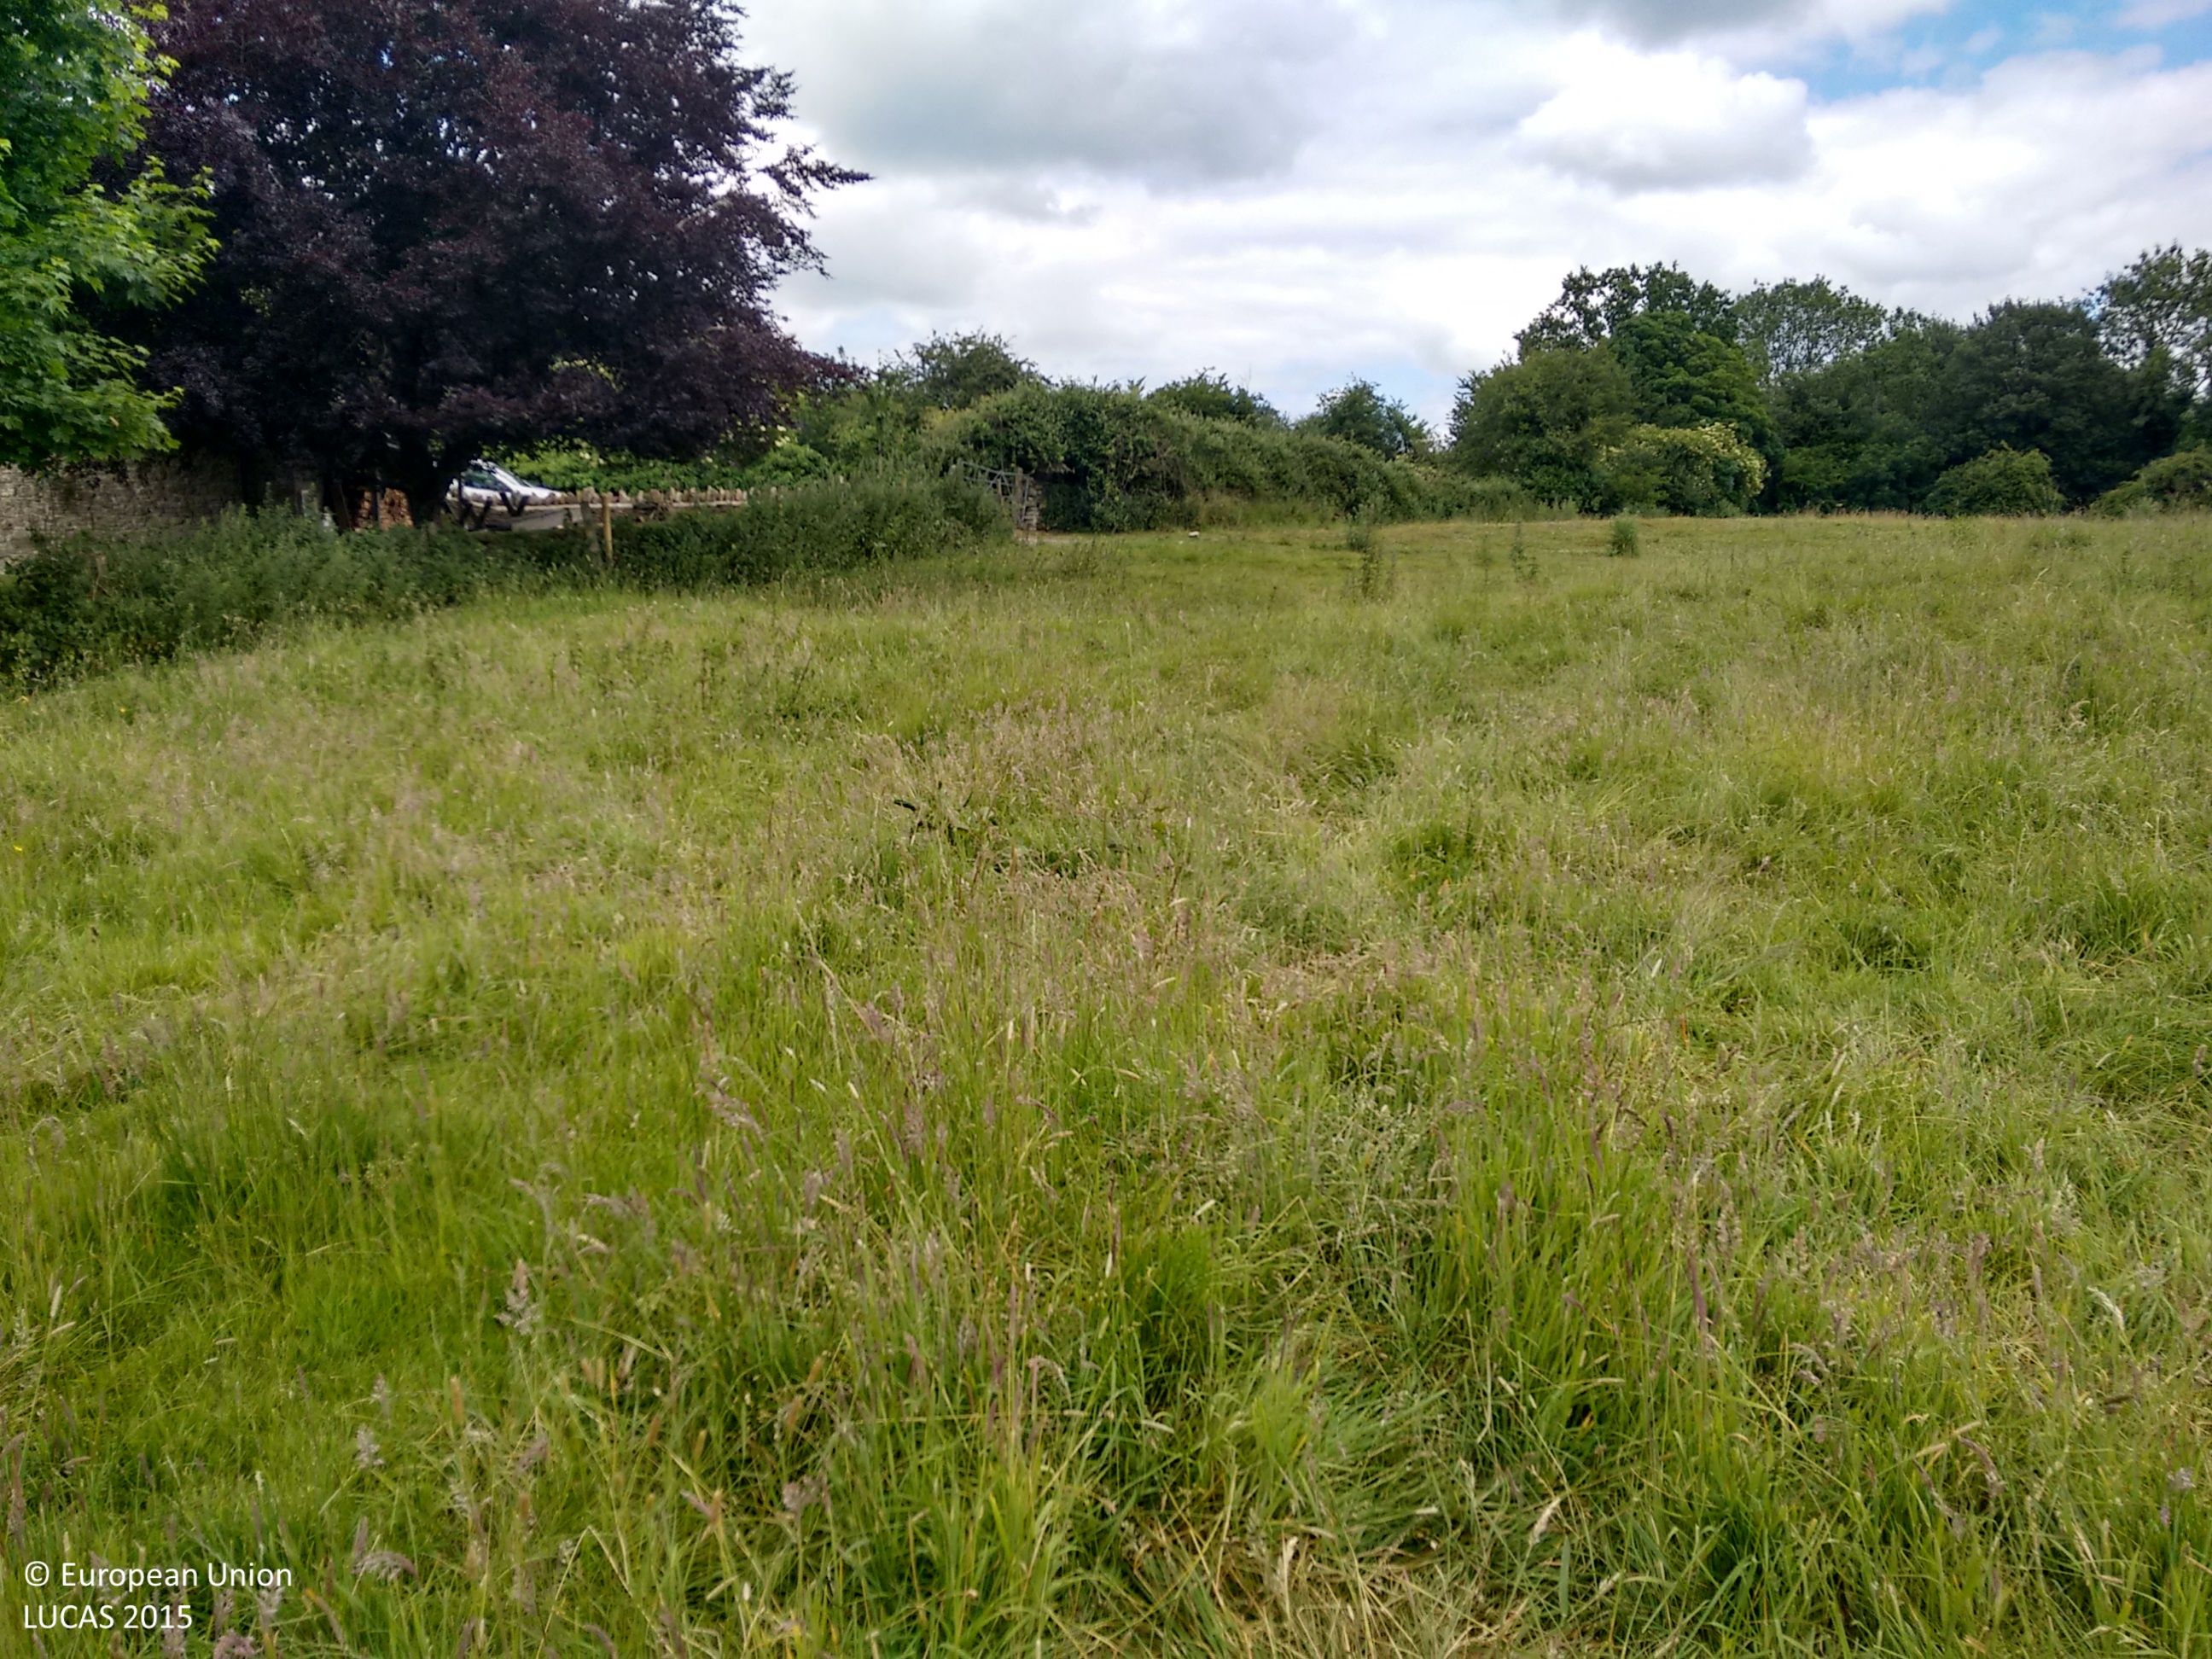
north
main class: Grassland
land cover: Grassland without tree/shrub cover
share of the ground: > 75 %
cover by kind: herbaceous plants 100 %
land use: Agriculture (excluding fallow land and kitchen gardens)
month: June
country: GB
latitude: 51.5967
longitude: -2.0558
